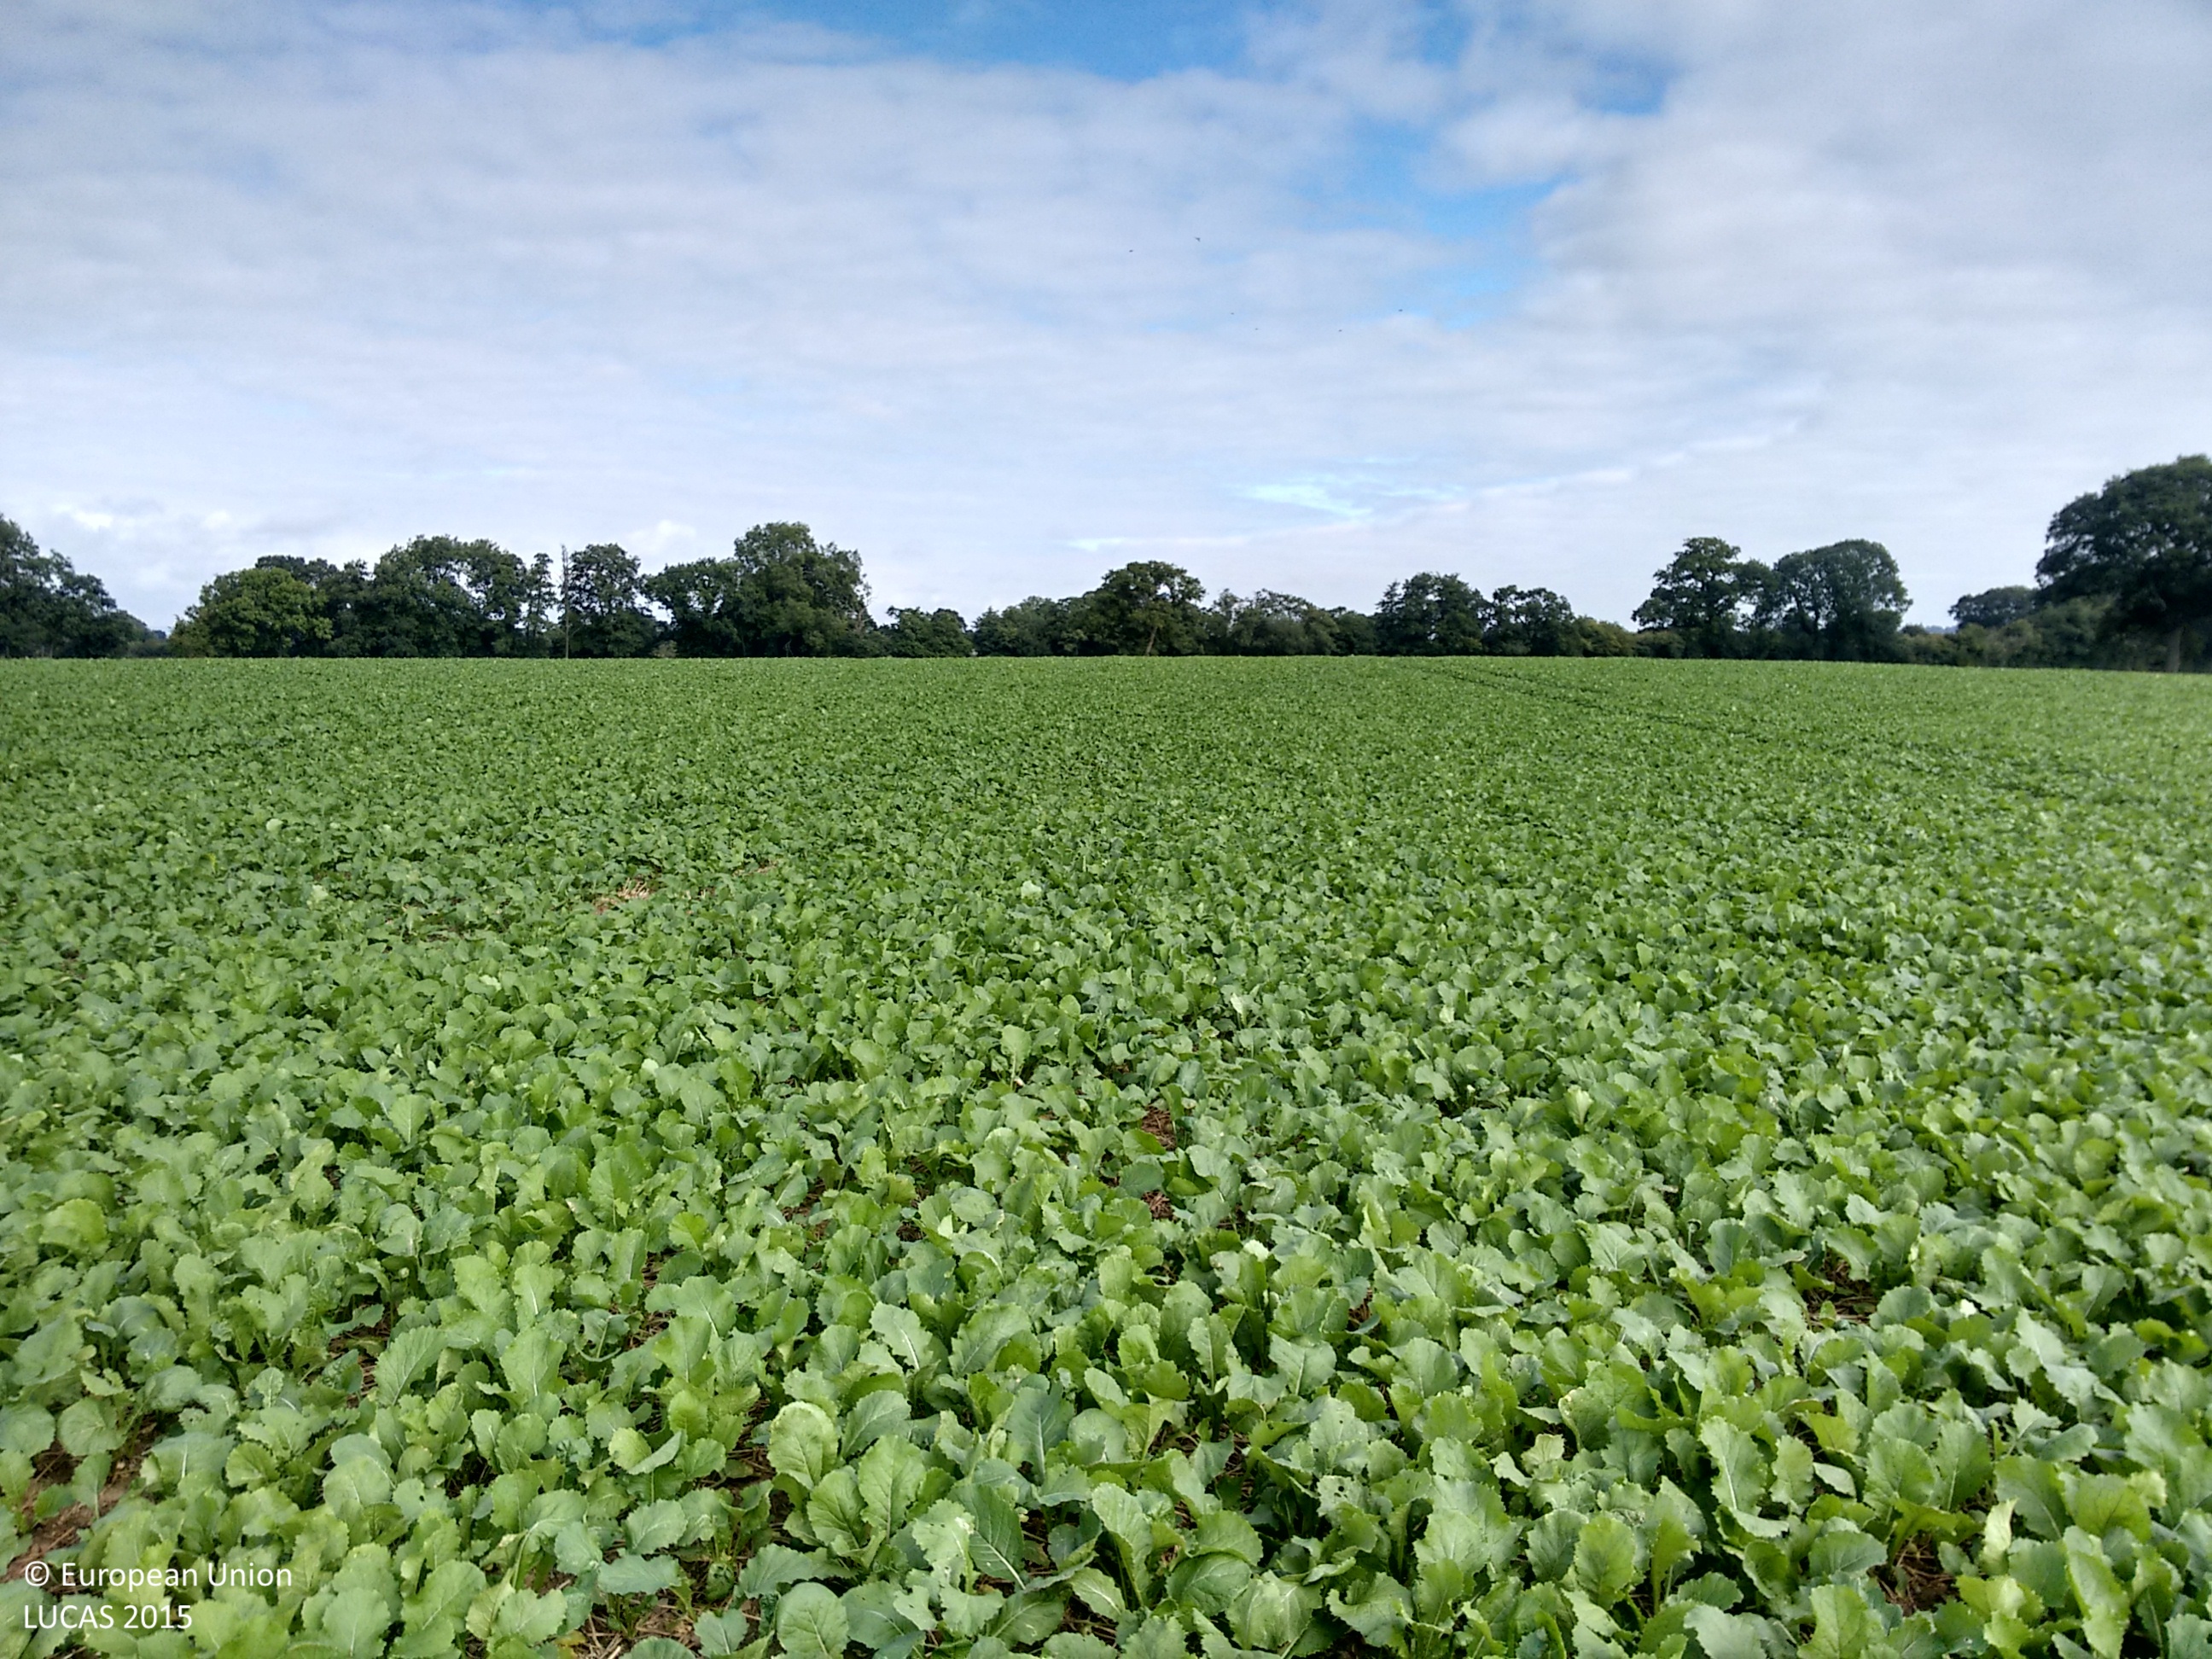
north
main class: Cropland
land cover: Sugar beet
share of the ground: > 75 %
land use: Agriculture (excluding fallow land and kitchen gardens)
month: September
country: GB
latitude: 52.8456
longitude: -2.9769
